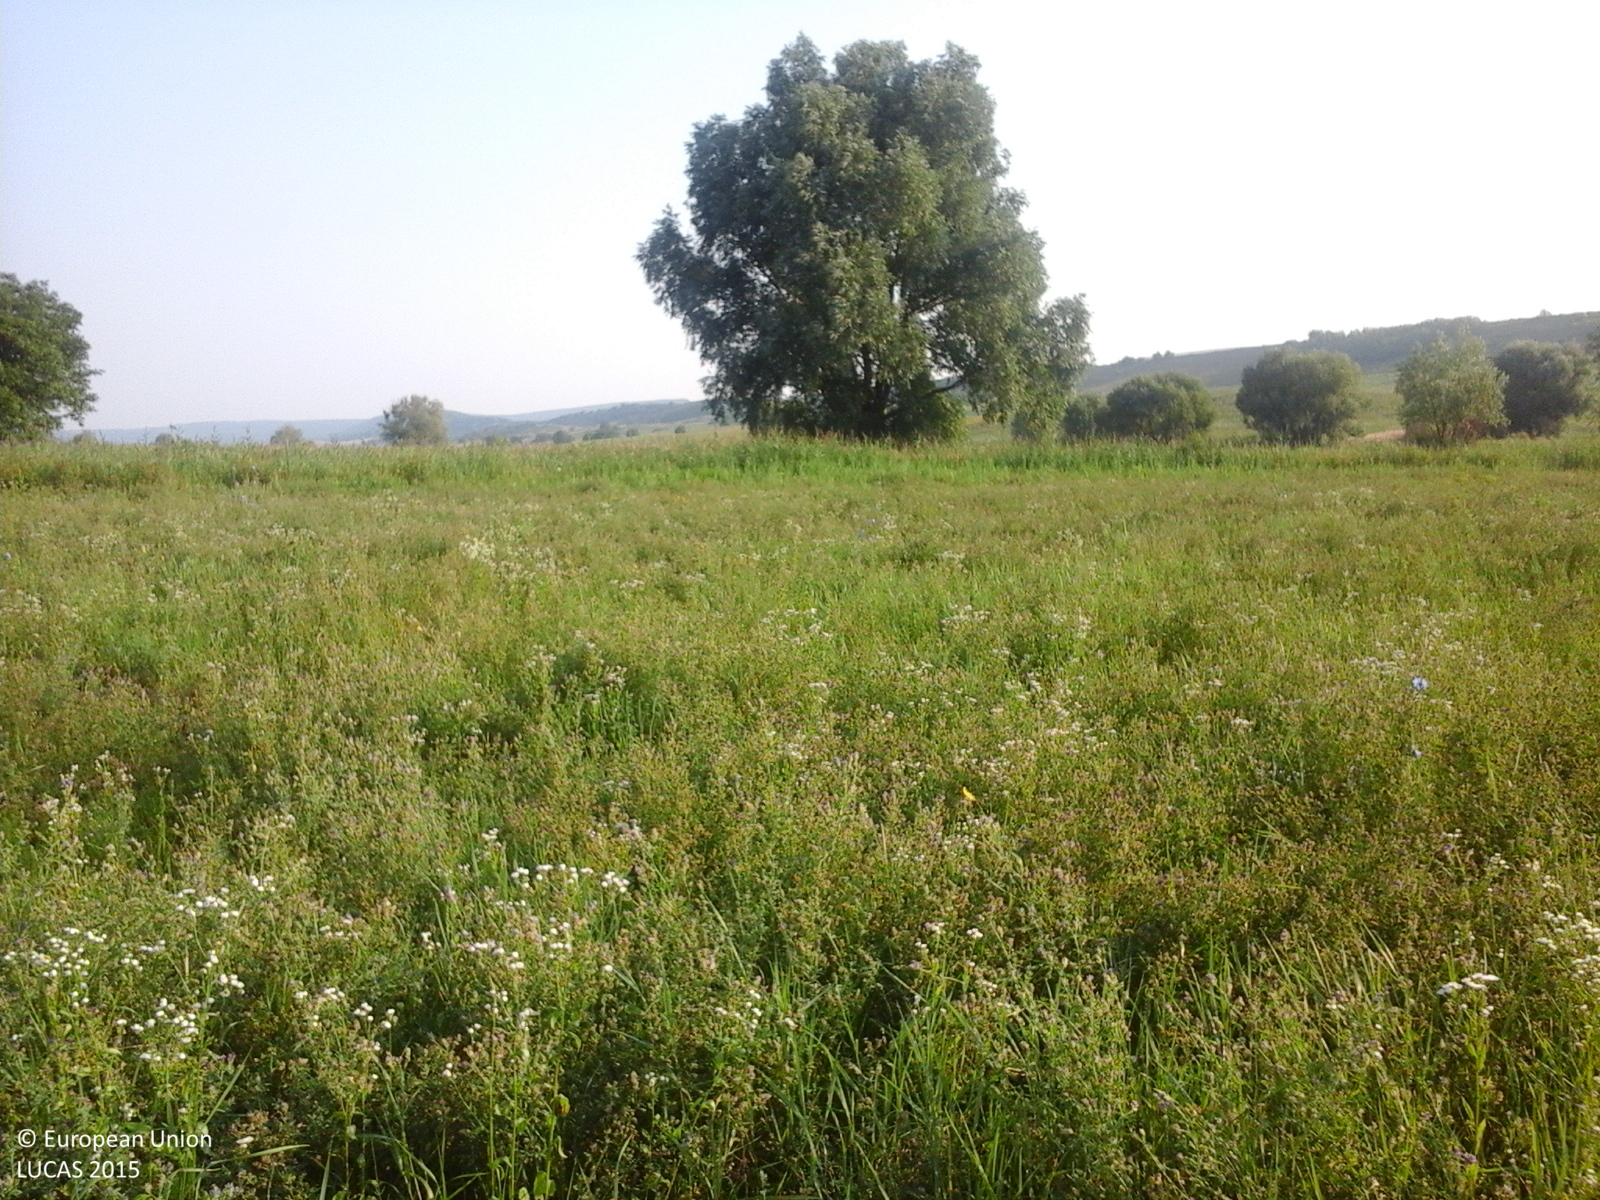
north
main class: Grassland
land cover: Spontaneously vegetated surfaces
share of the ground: > 75 %
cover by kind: herbaceous plants 100 %
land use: Fallow land
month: July
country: RO
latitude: 46.5088
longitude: 27.6437
